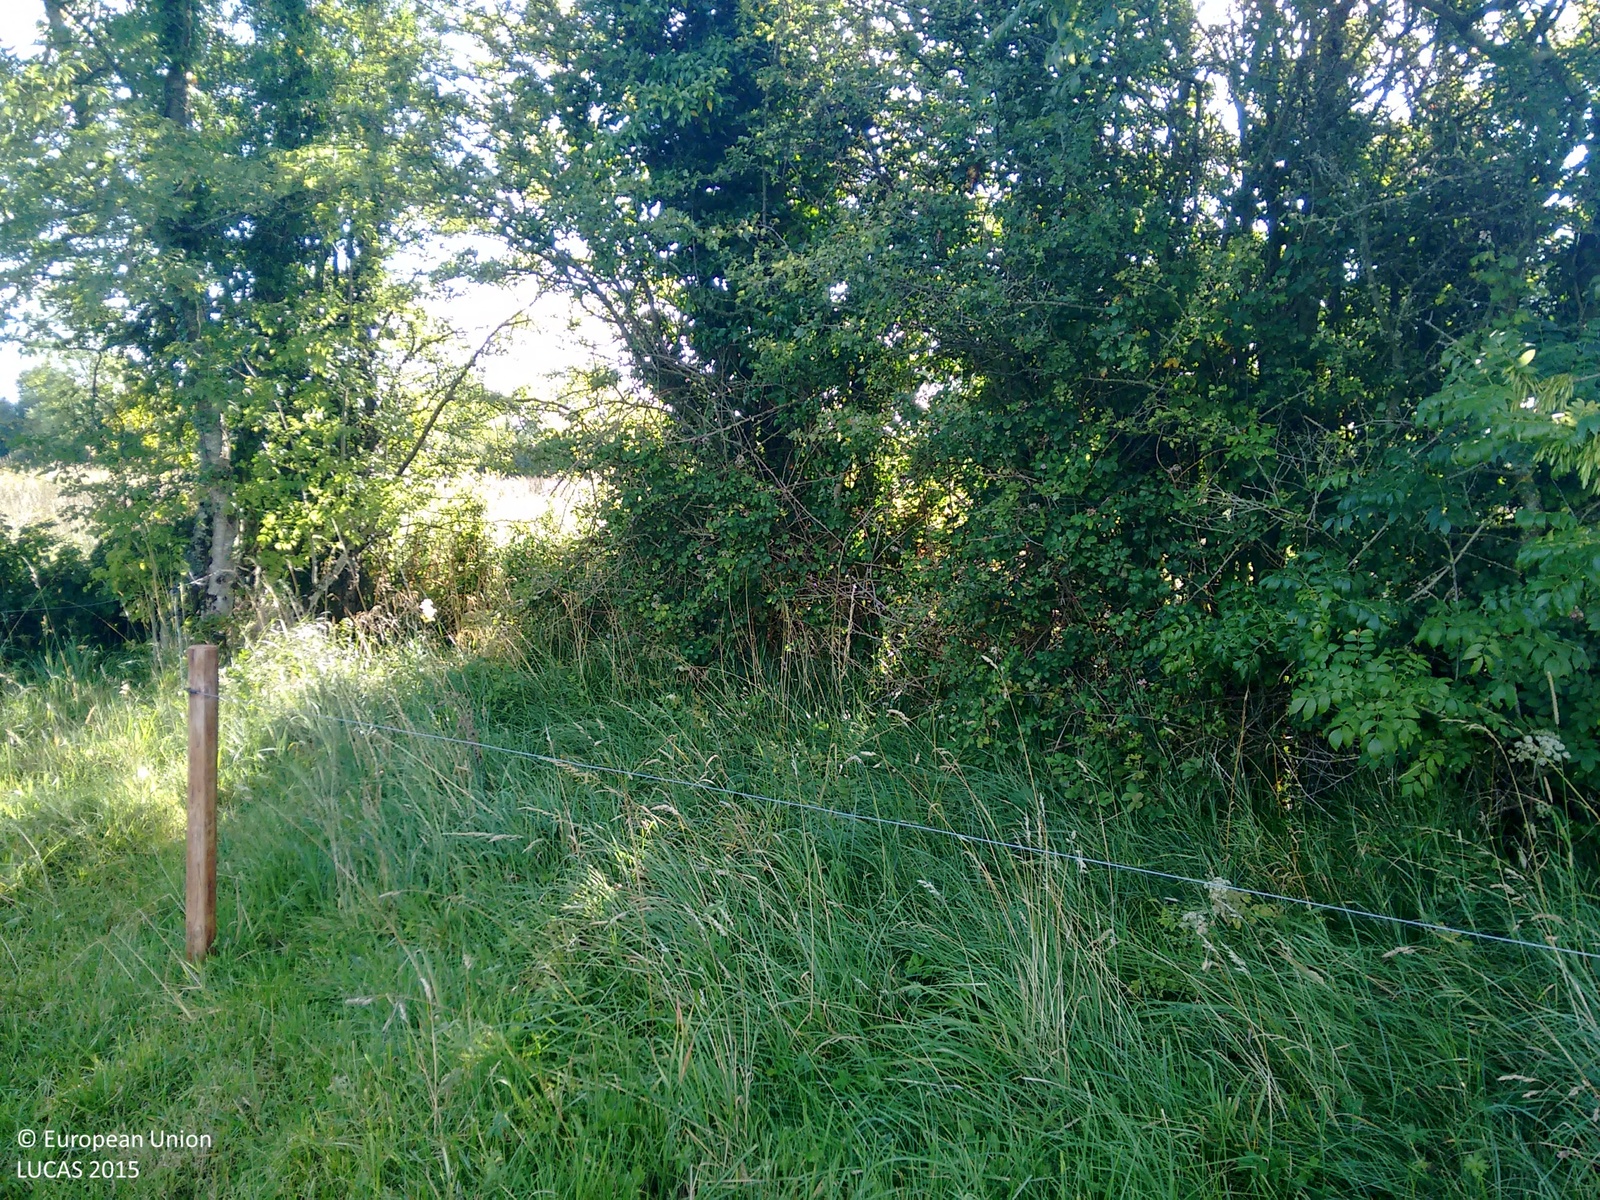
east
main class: Grassland
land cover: Grassland without tree/shrub cover
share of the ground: > 75 %
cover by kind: herbaceous plants 100 %
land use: Agriculture (excluding fallow land and kitchen gardens)
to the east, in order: Grassland without tree/shrub cover; Fences; Grass margins; Abandoned hedges; Ditches and canals; Abandoned hedges; Fences; Spontaneously vegetated surfaces; Fences; Grass margins; Rivers and streams; Abandoned hedges; Fences; Grassland without tree/shrub cover; Electric lines; Grassland without tree/shrub cover; Fences; Abandoned hedges; Fences; Grassland without tree/shrub cover
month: August
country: IE
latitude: 52.5291
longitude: -8.2723
